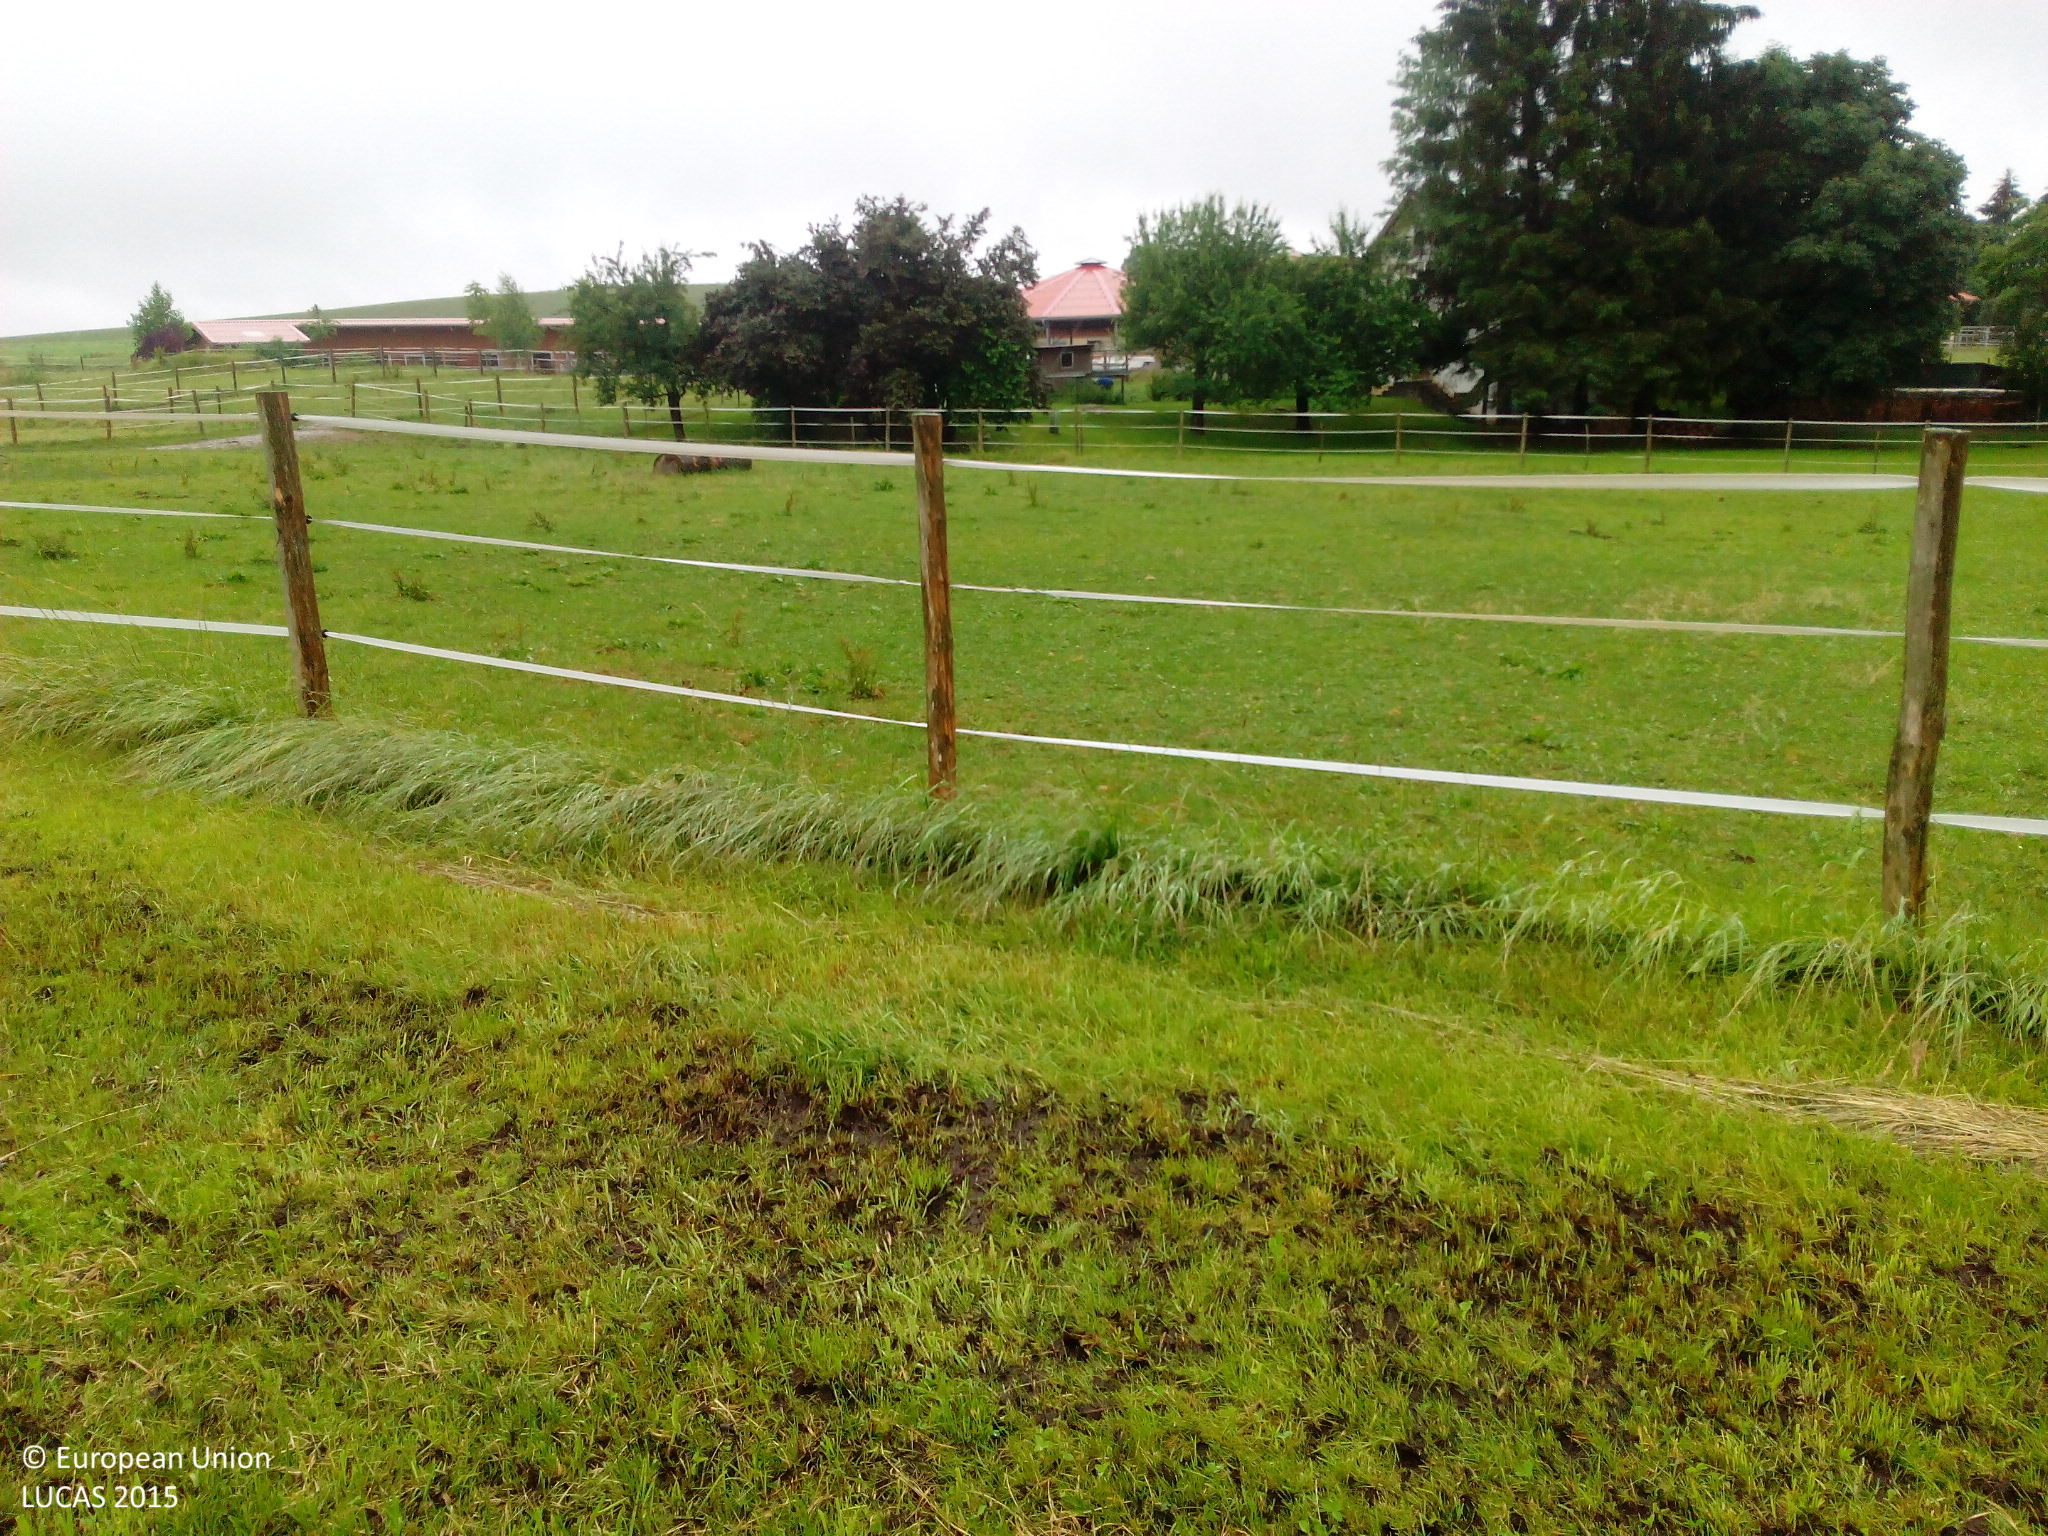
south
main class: Grassland
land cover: Grassland without tree/shrub cover
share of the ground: > 75 %
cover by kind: herbaceous plants 100 %
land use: Agriculture (excluding fallow land and kitchen gardens)
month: June
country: DE
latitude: 47.6655
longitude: 9.8536
